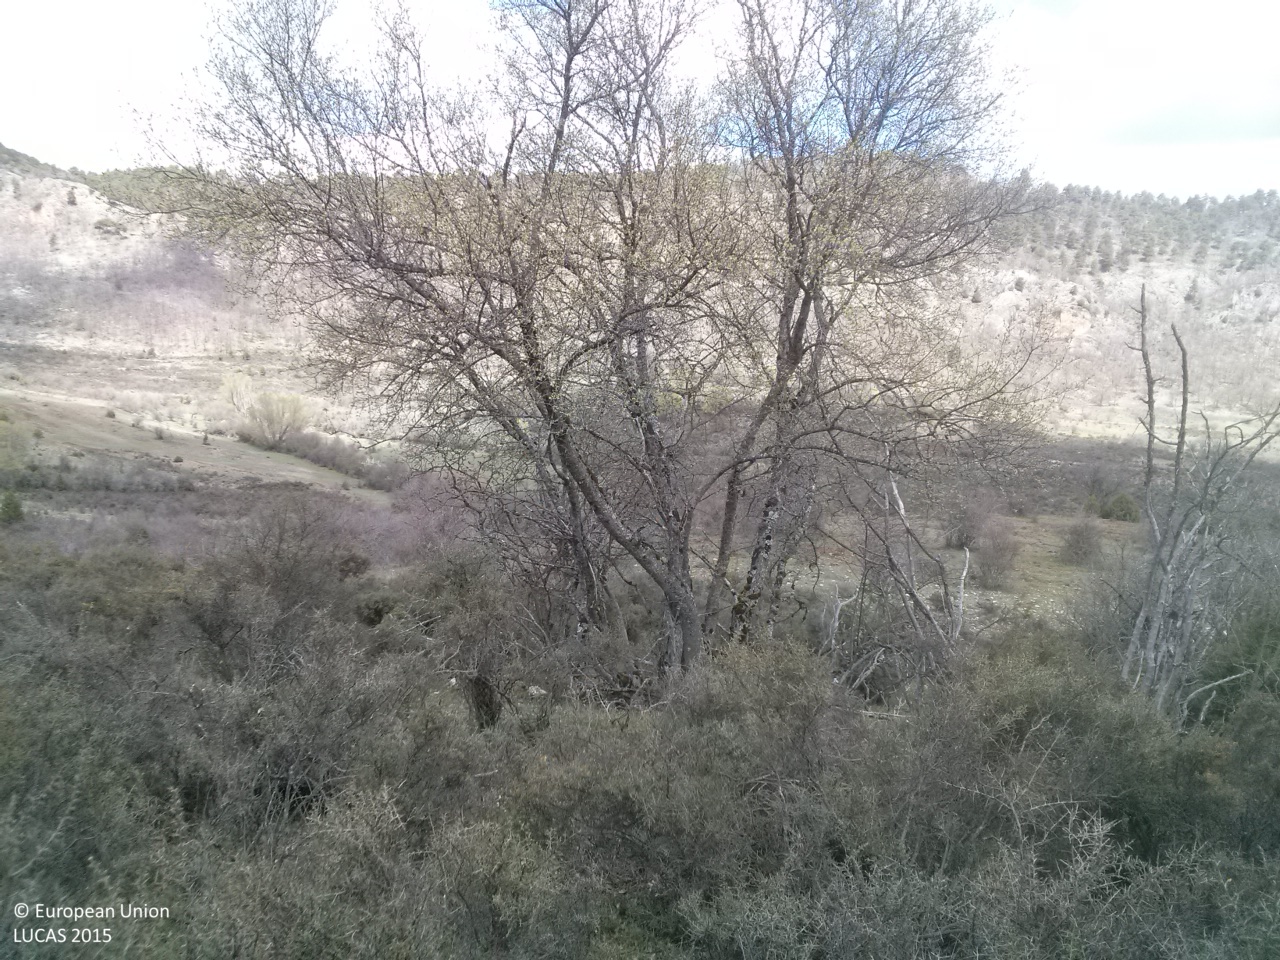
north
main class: Artificial land
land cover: Other artificial areas
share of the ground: < 10 %
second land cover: Shrubland with sparse tree cover
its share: > 75 %
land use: Electricity, gas and thermal power distribution
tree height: > 5 m
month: April
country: ES
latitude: 40.2788
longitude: -1.8356
